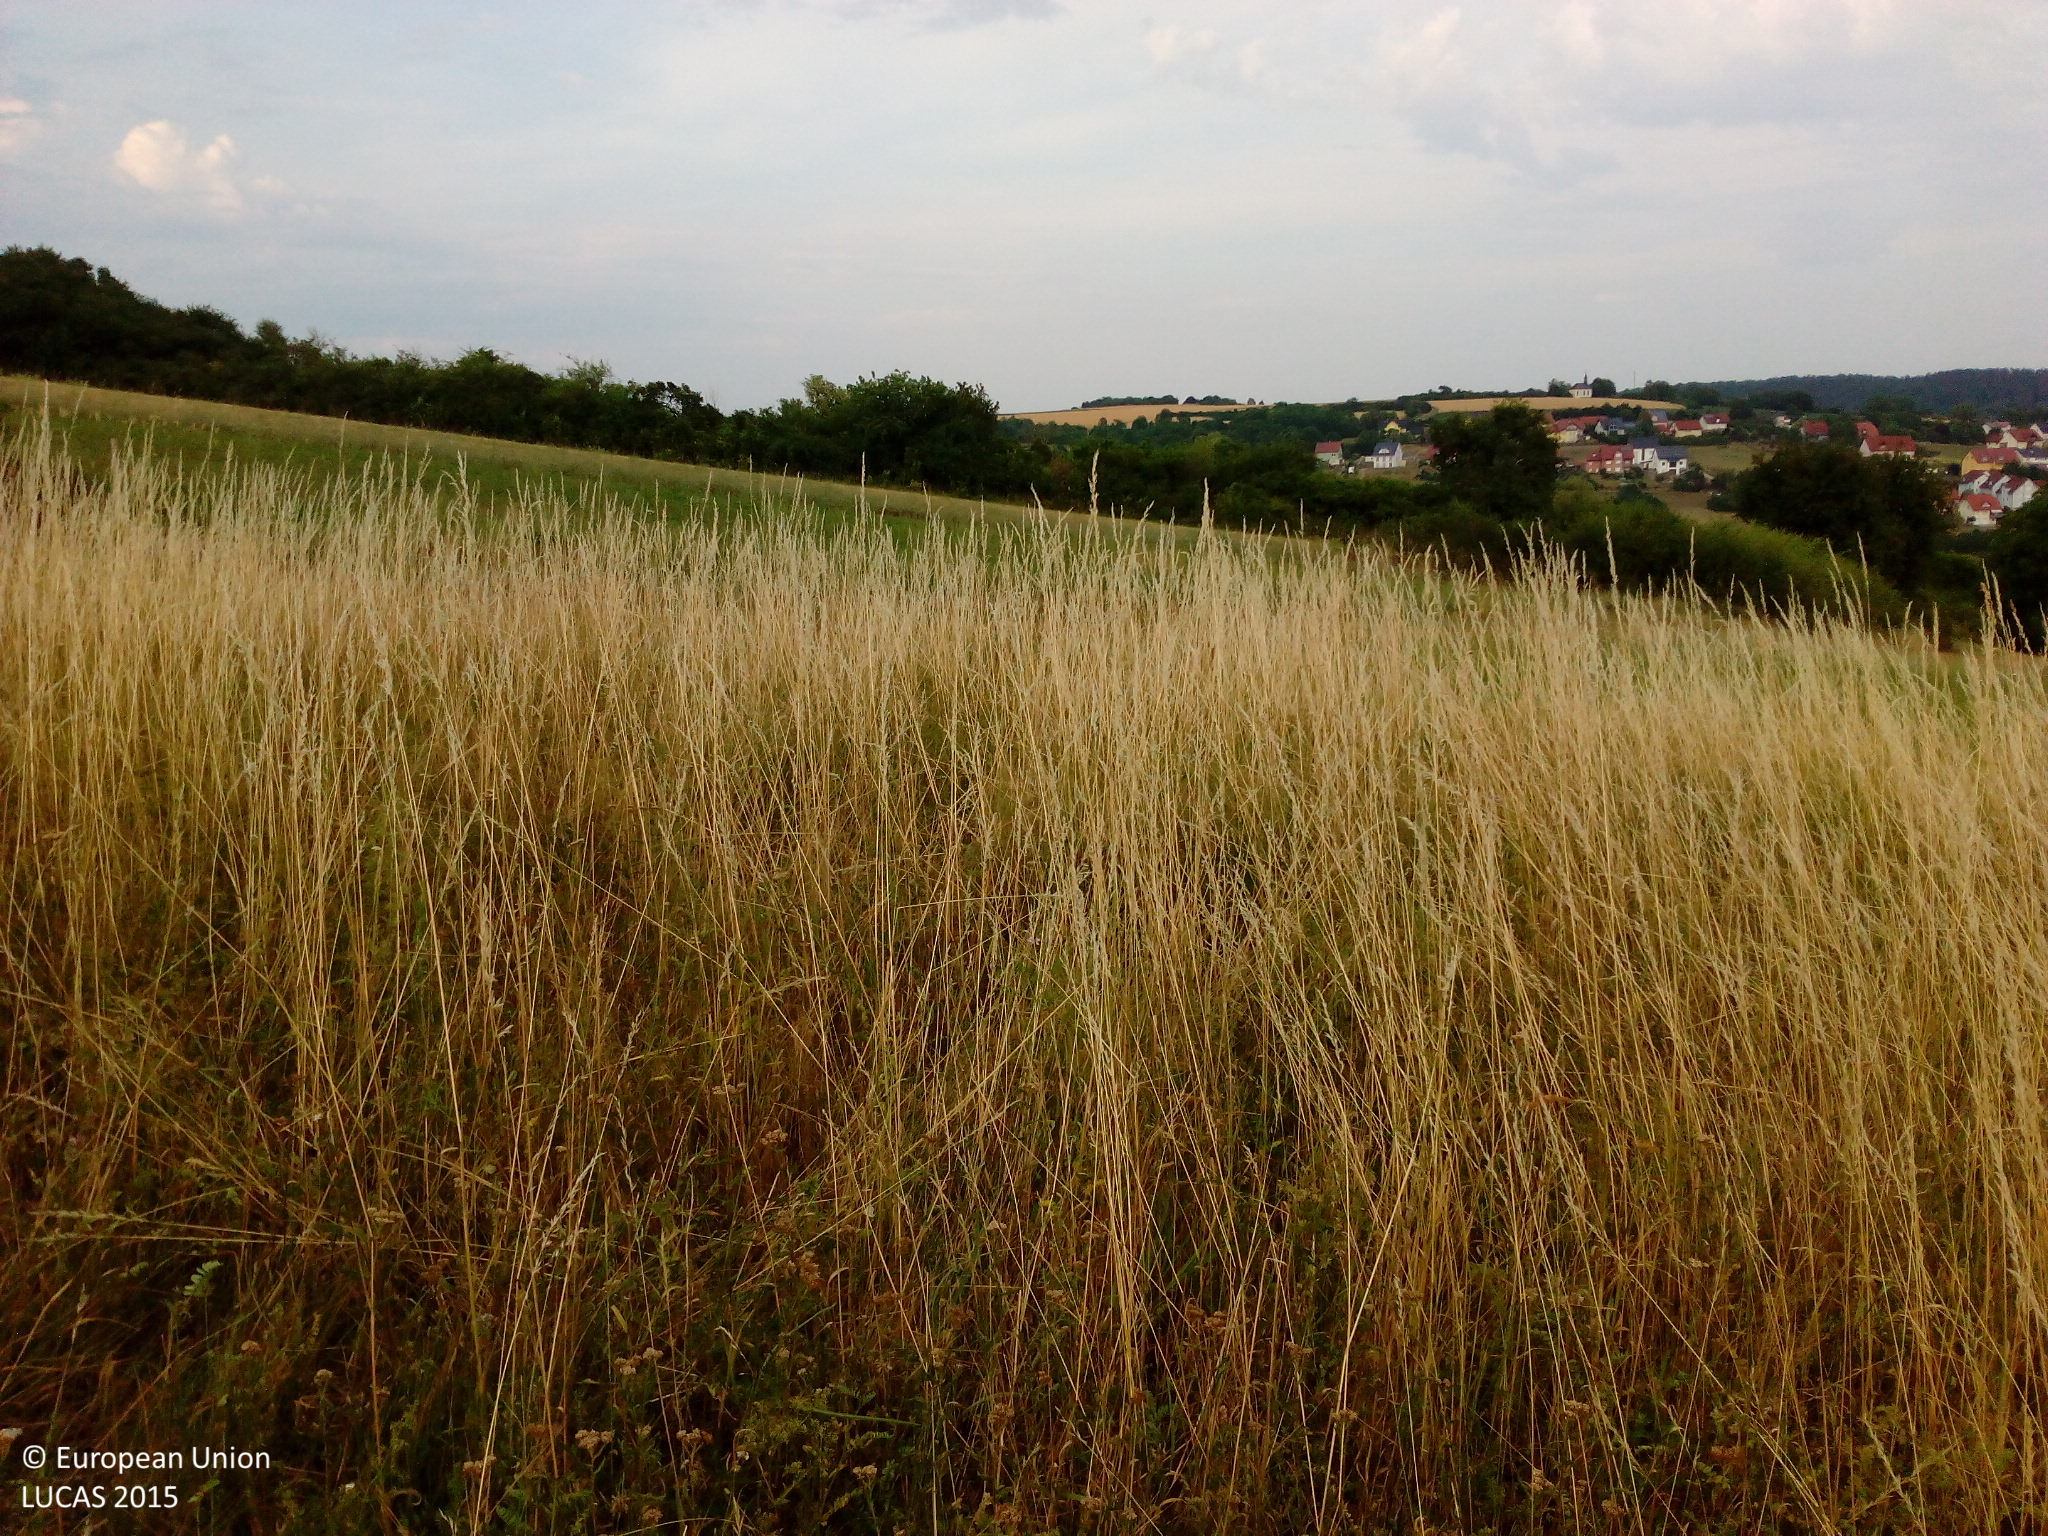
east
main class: Grassland
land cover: Grassland without tree/shrub cover
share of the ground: > 75 %
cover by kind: herbaceous plants 100 %
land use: Agriculture (excluding fallow land and kitchen gardens)
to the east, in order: Grassland without tree/shrub cover; Clovers; Tracks; Clovers; Grassland without tree/shrub cover; Shrubland with sparse tree cover; Spontaneously vegetated surfaces; Abandoned hedges; Grassland without tree/shrub cover; Shrubland without tree cover; Dry stone walls; Grassland without tree/shrub cover; Shrubland with sparse tree cover; Grassland with sparse tree/shrub cover
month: July
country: DE
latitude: 49.5188
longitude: 9.9586
